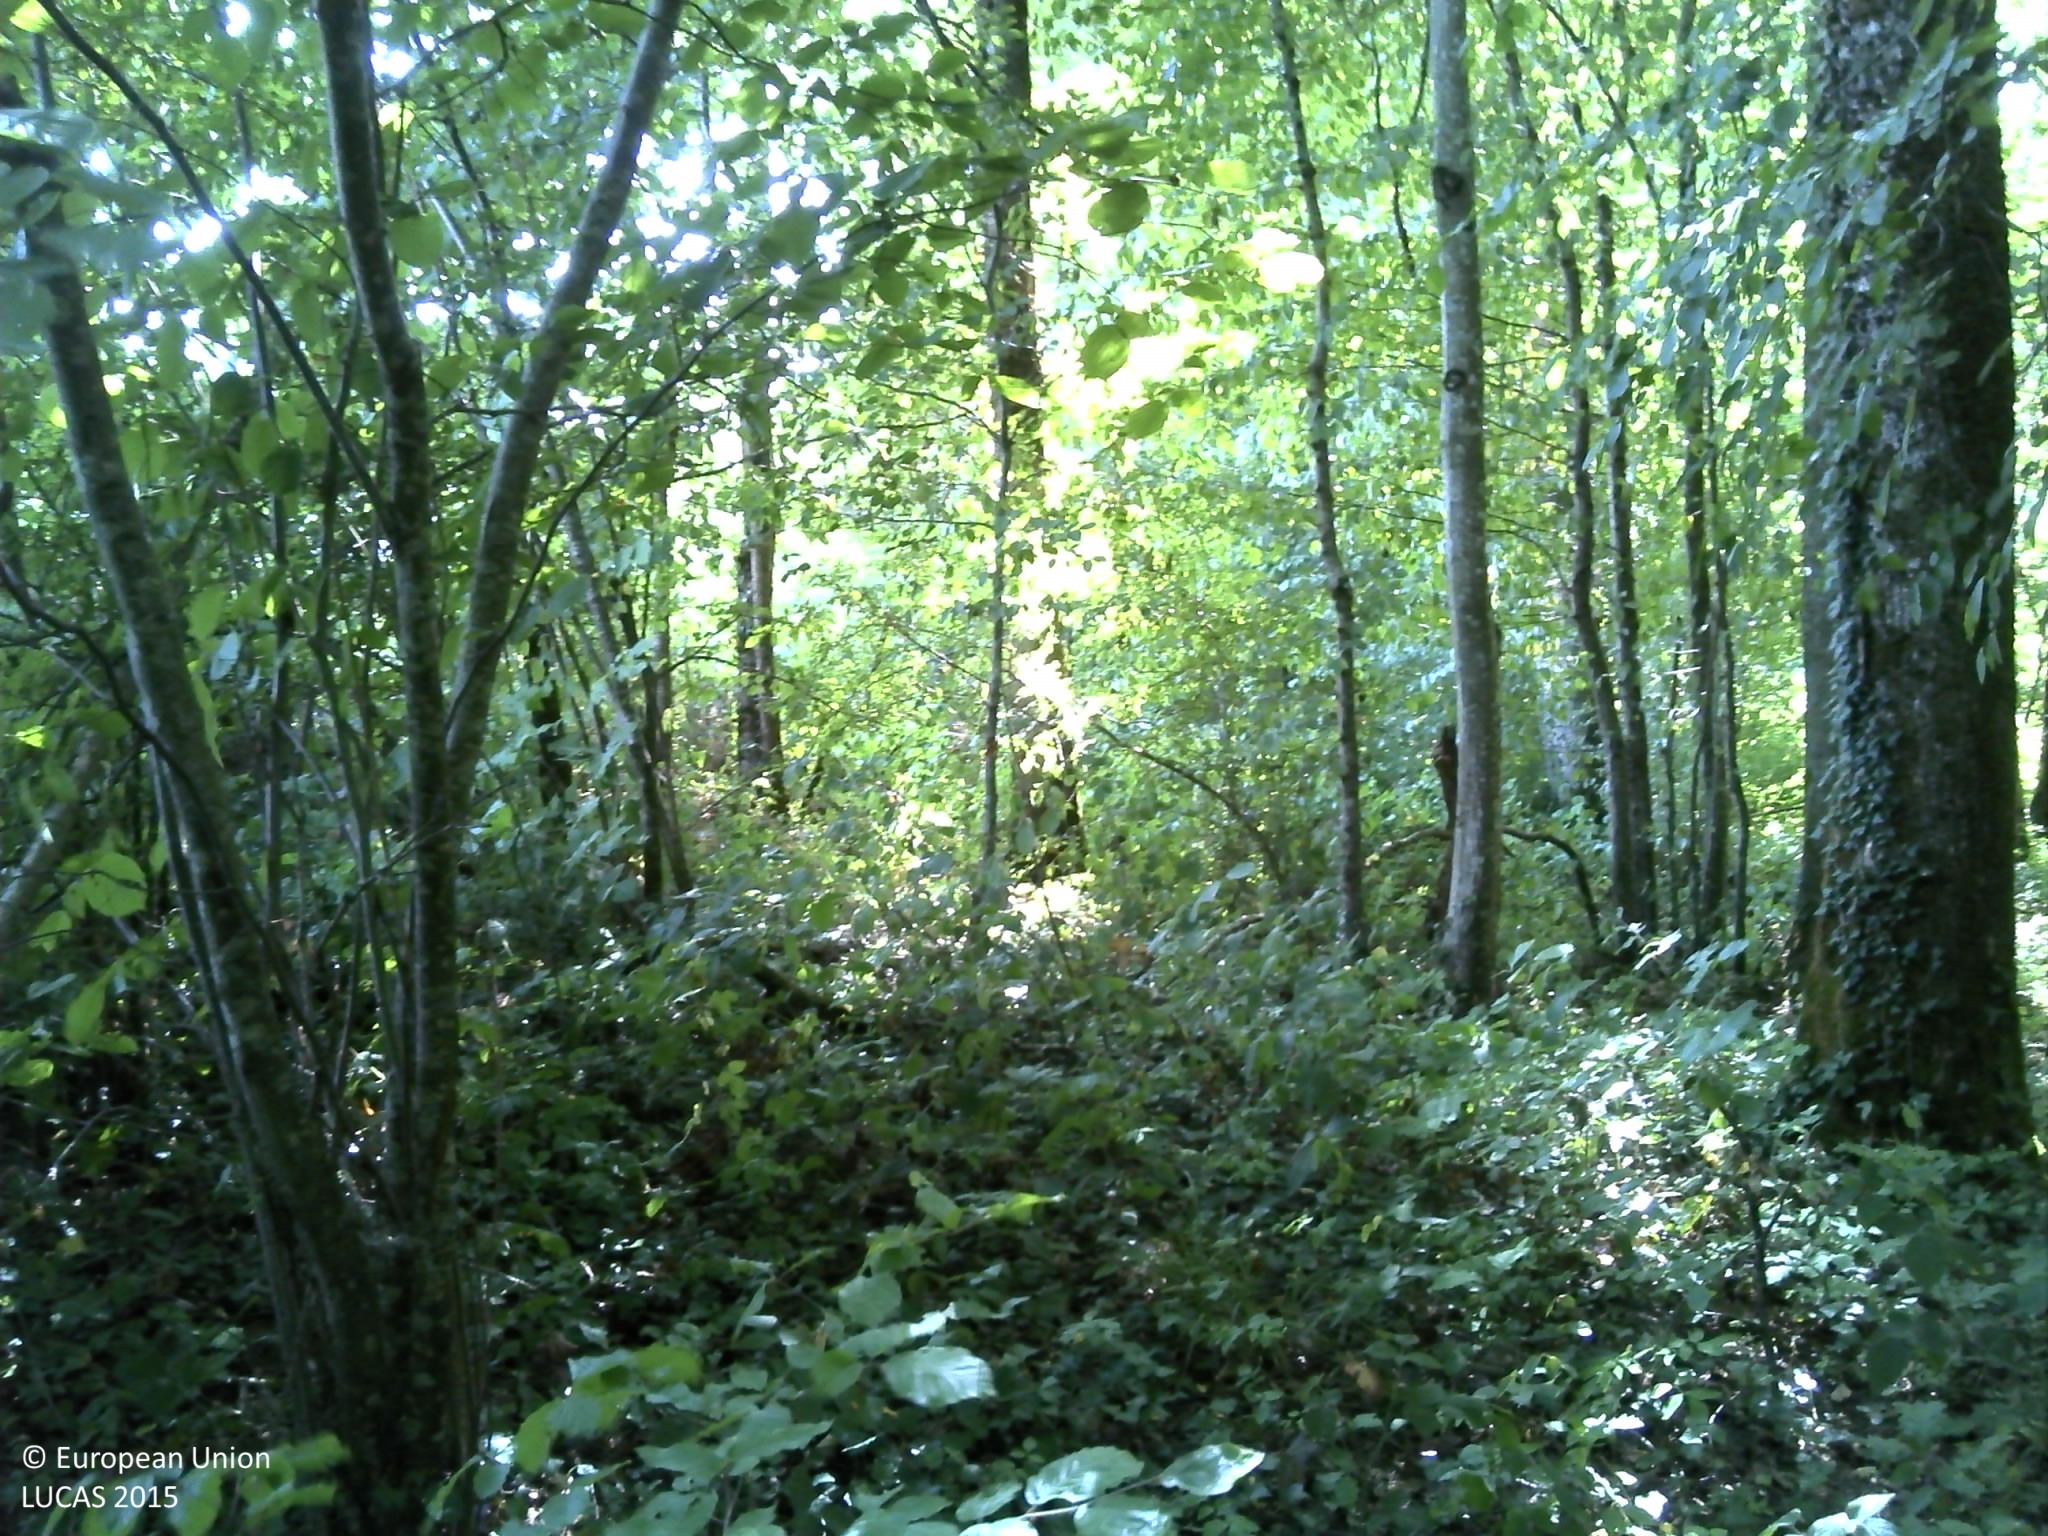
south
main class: Woodland
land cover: Broadleaved woodland
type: beech forest
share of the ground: > 75 %
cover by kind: broadleaved forest trees 90 %, coniferous forest trees 10 %
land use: Forestry
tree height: > 5 m
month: July
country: FR
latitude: 48.8800
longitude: 4.8842
